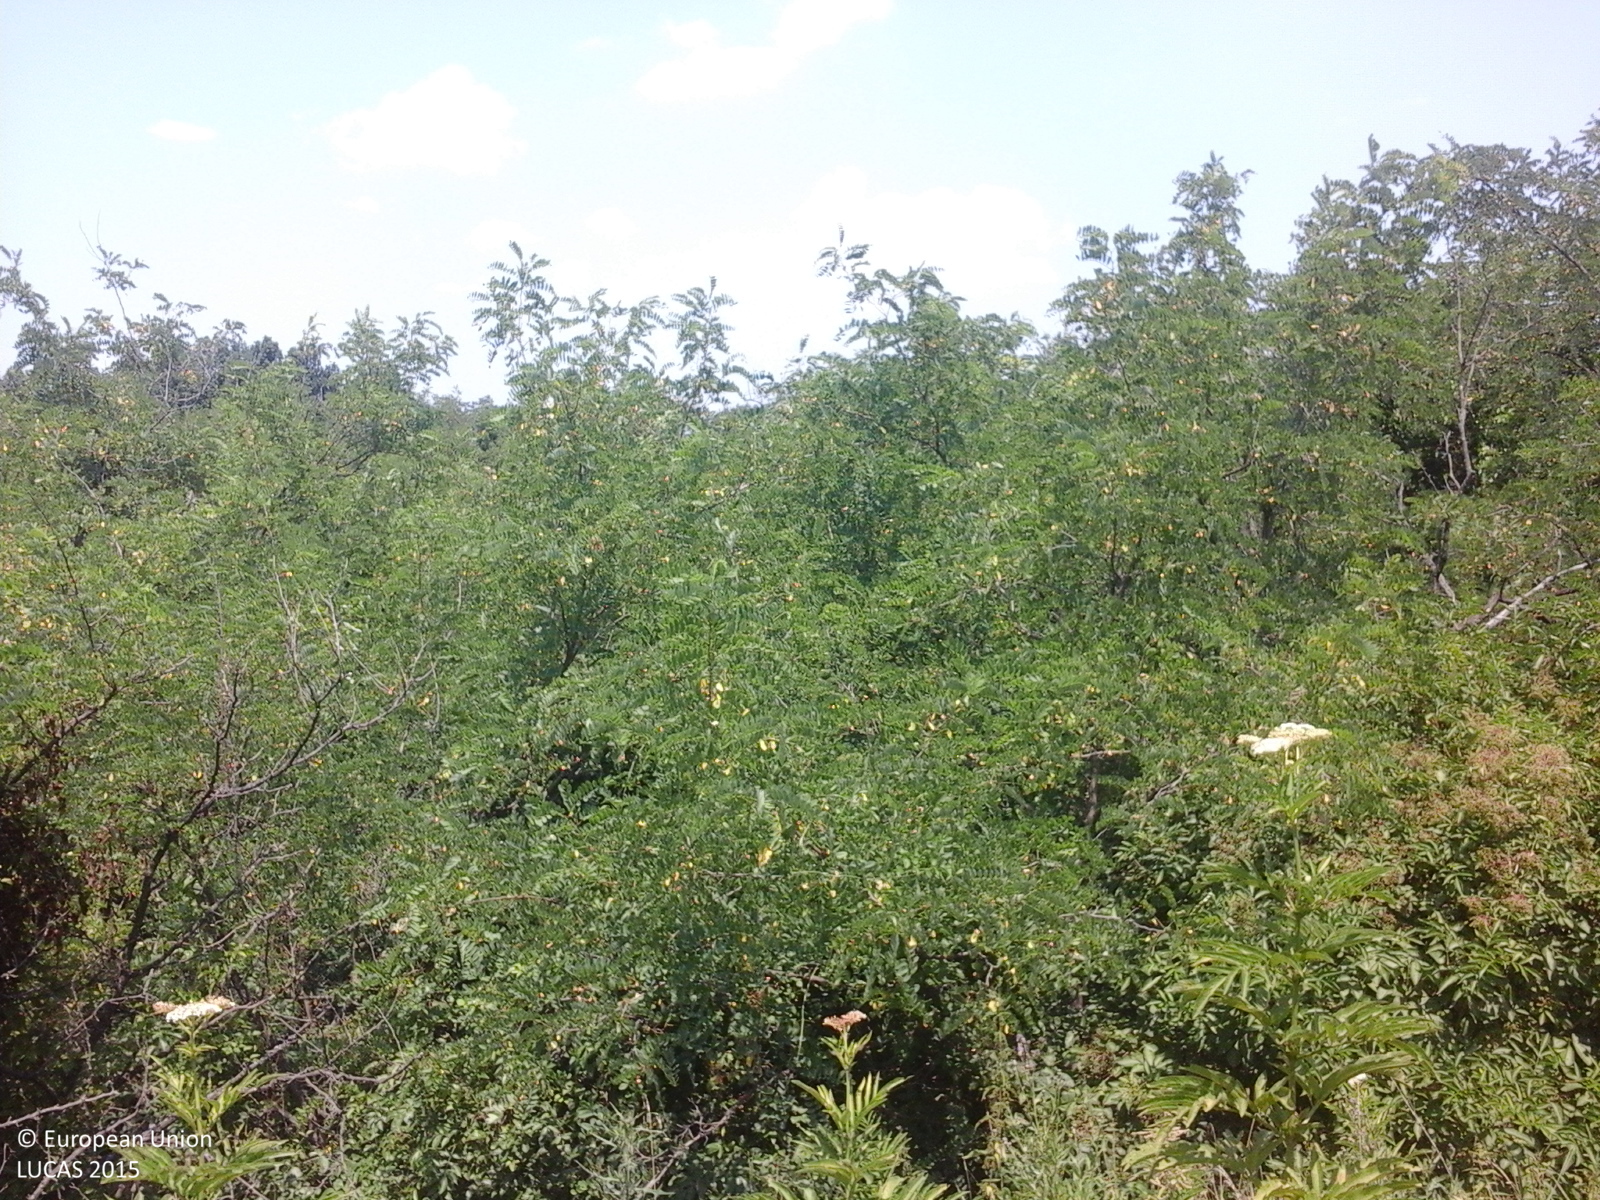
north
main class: Woodland
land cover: Broadleaved woodland
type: exotic forest
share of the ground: > 75 %
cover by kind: broadleaved forest trees 100 %
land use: Forestry
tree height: > 5 m
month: July
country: RO
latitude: 44.7267
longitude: 24.4274
